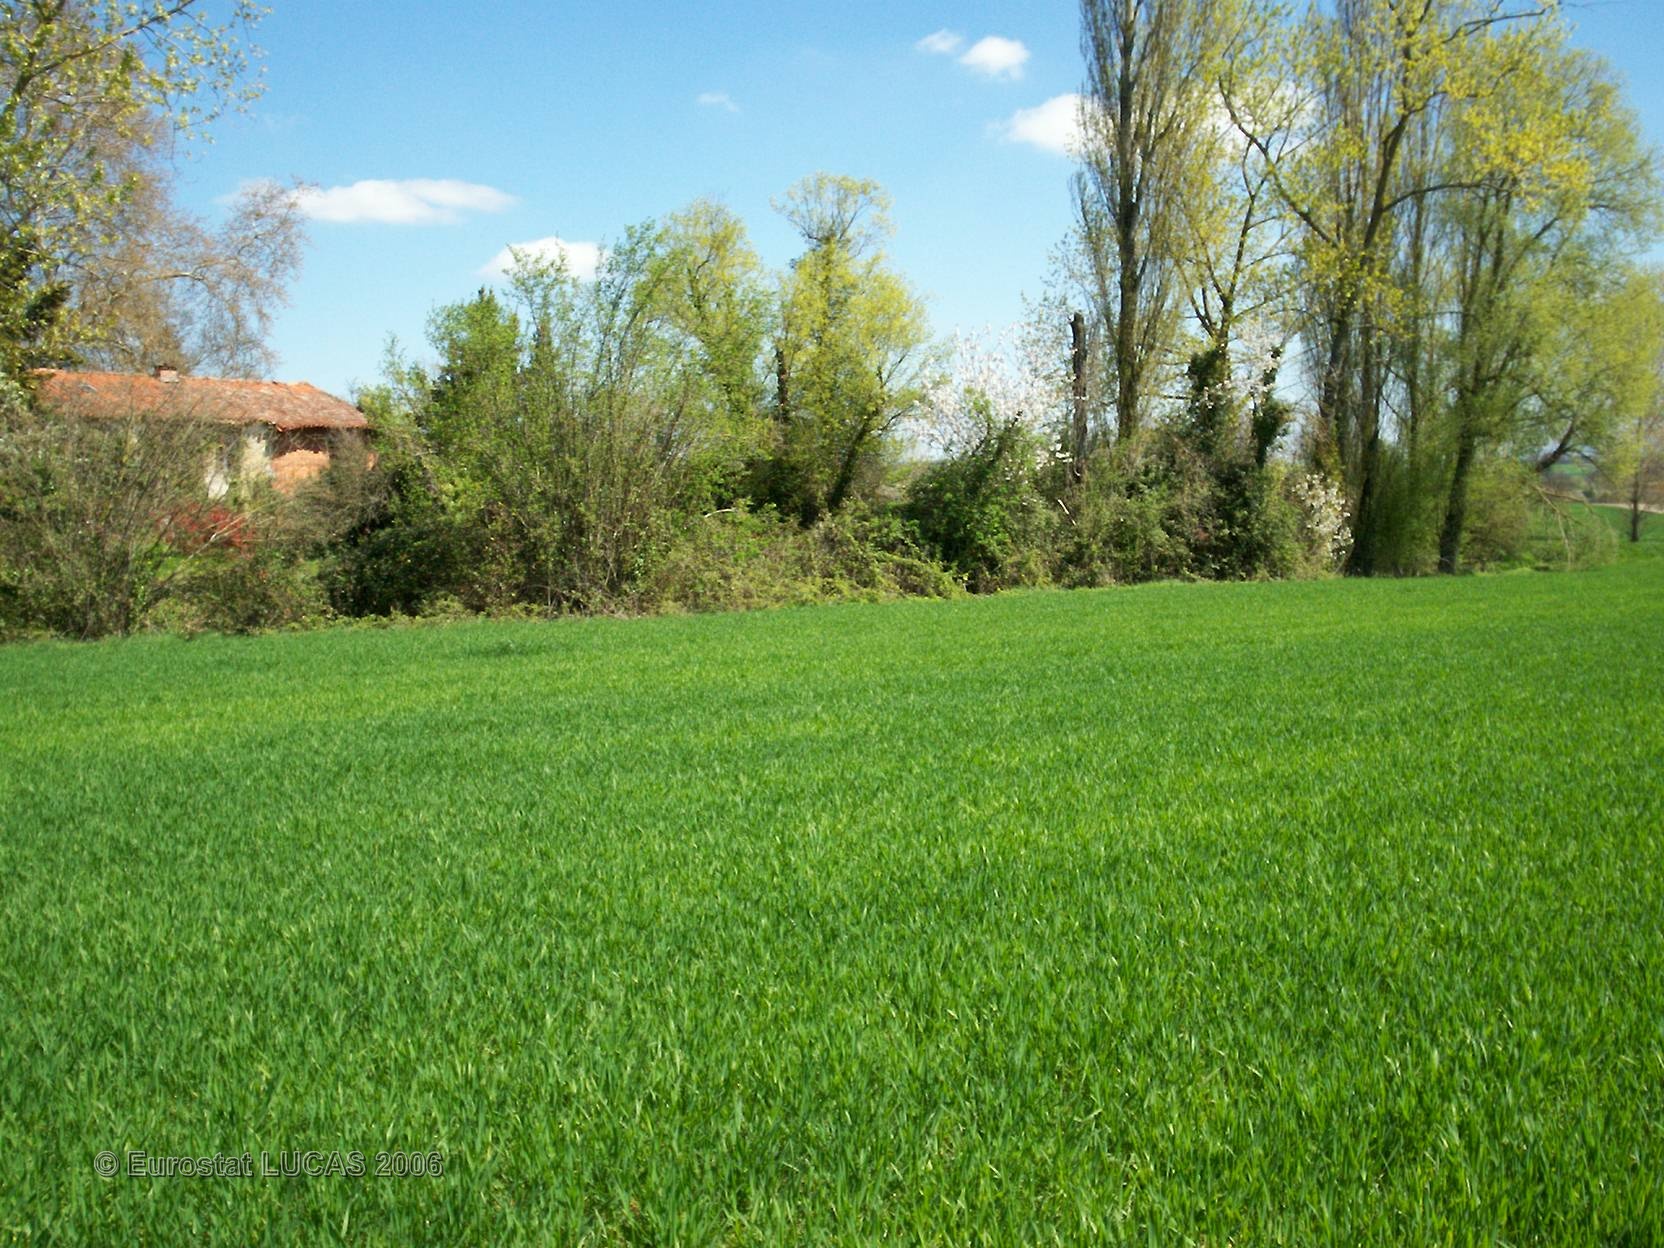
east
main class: Cropland
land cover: Barley
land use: Agriculture (excluding fallow land and kitchen gardens)
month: April
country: FR
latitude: 43.5537
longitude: 2.0211
